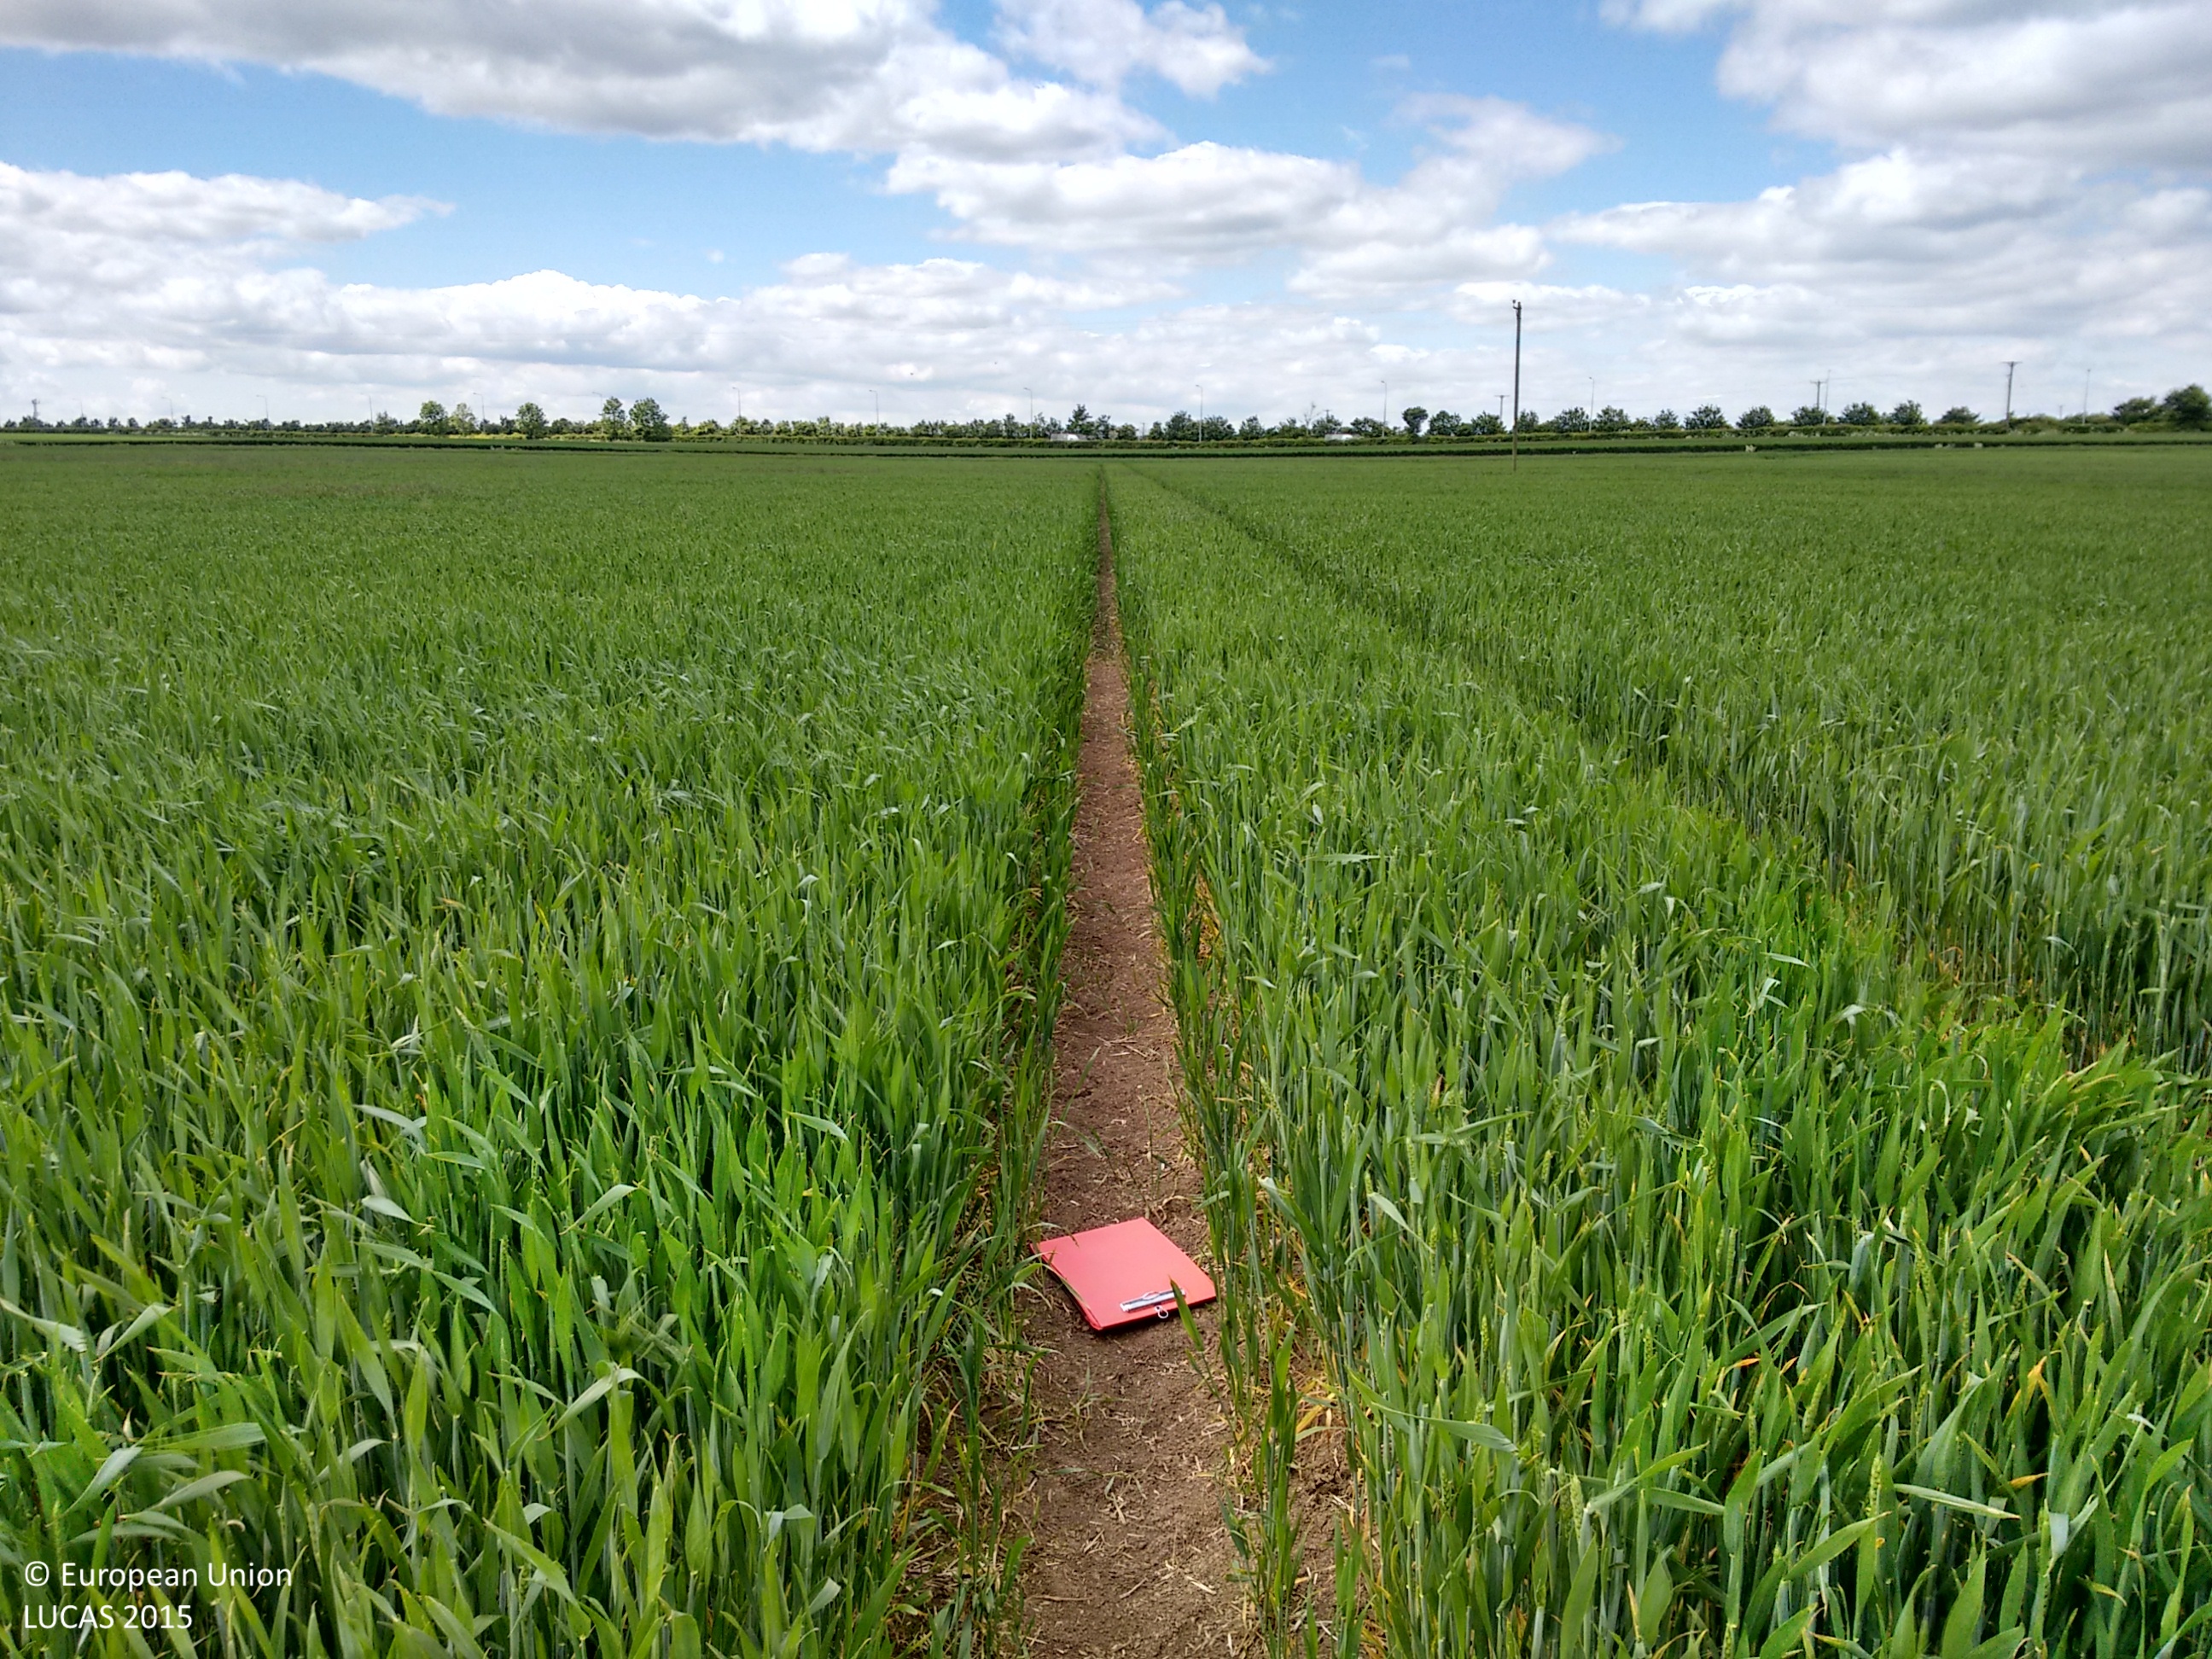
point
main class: Cropland
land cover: Common wheat
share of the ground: > 75 %
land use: Agriculture (excluding fallow land and kitchen gardens)
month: June
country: GB
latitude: 53.5431
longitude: -0.0677
